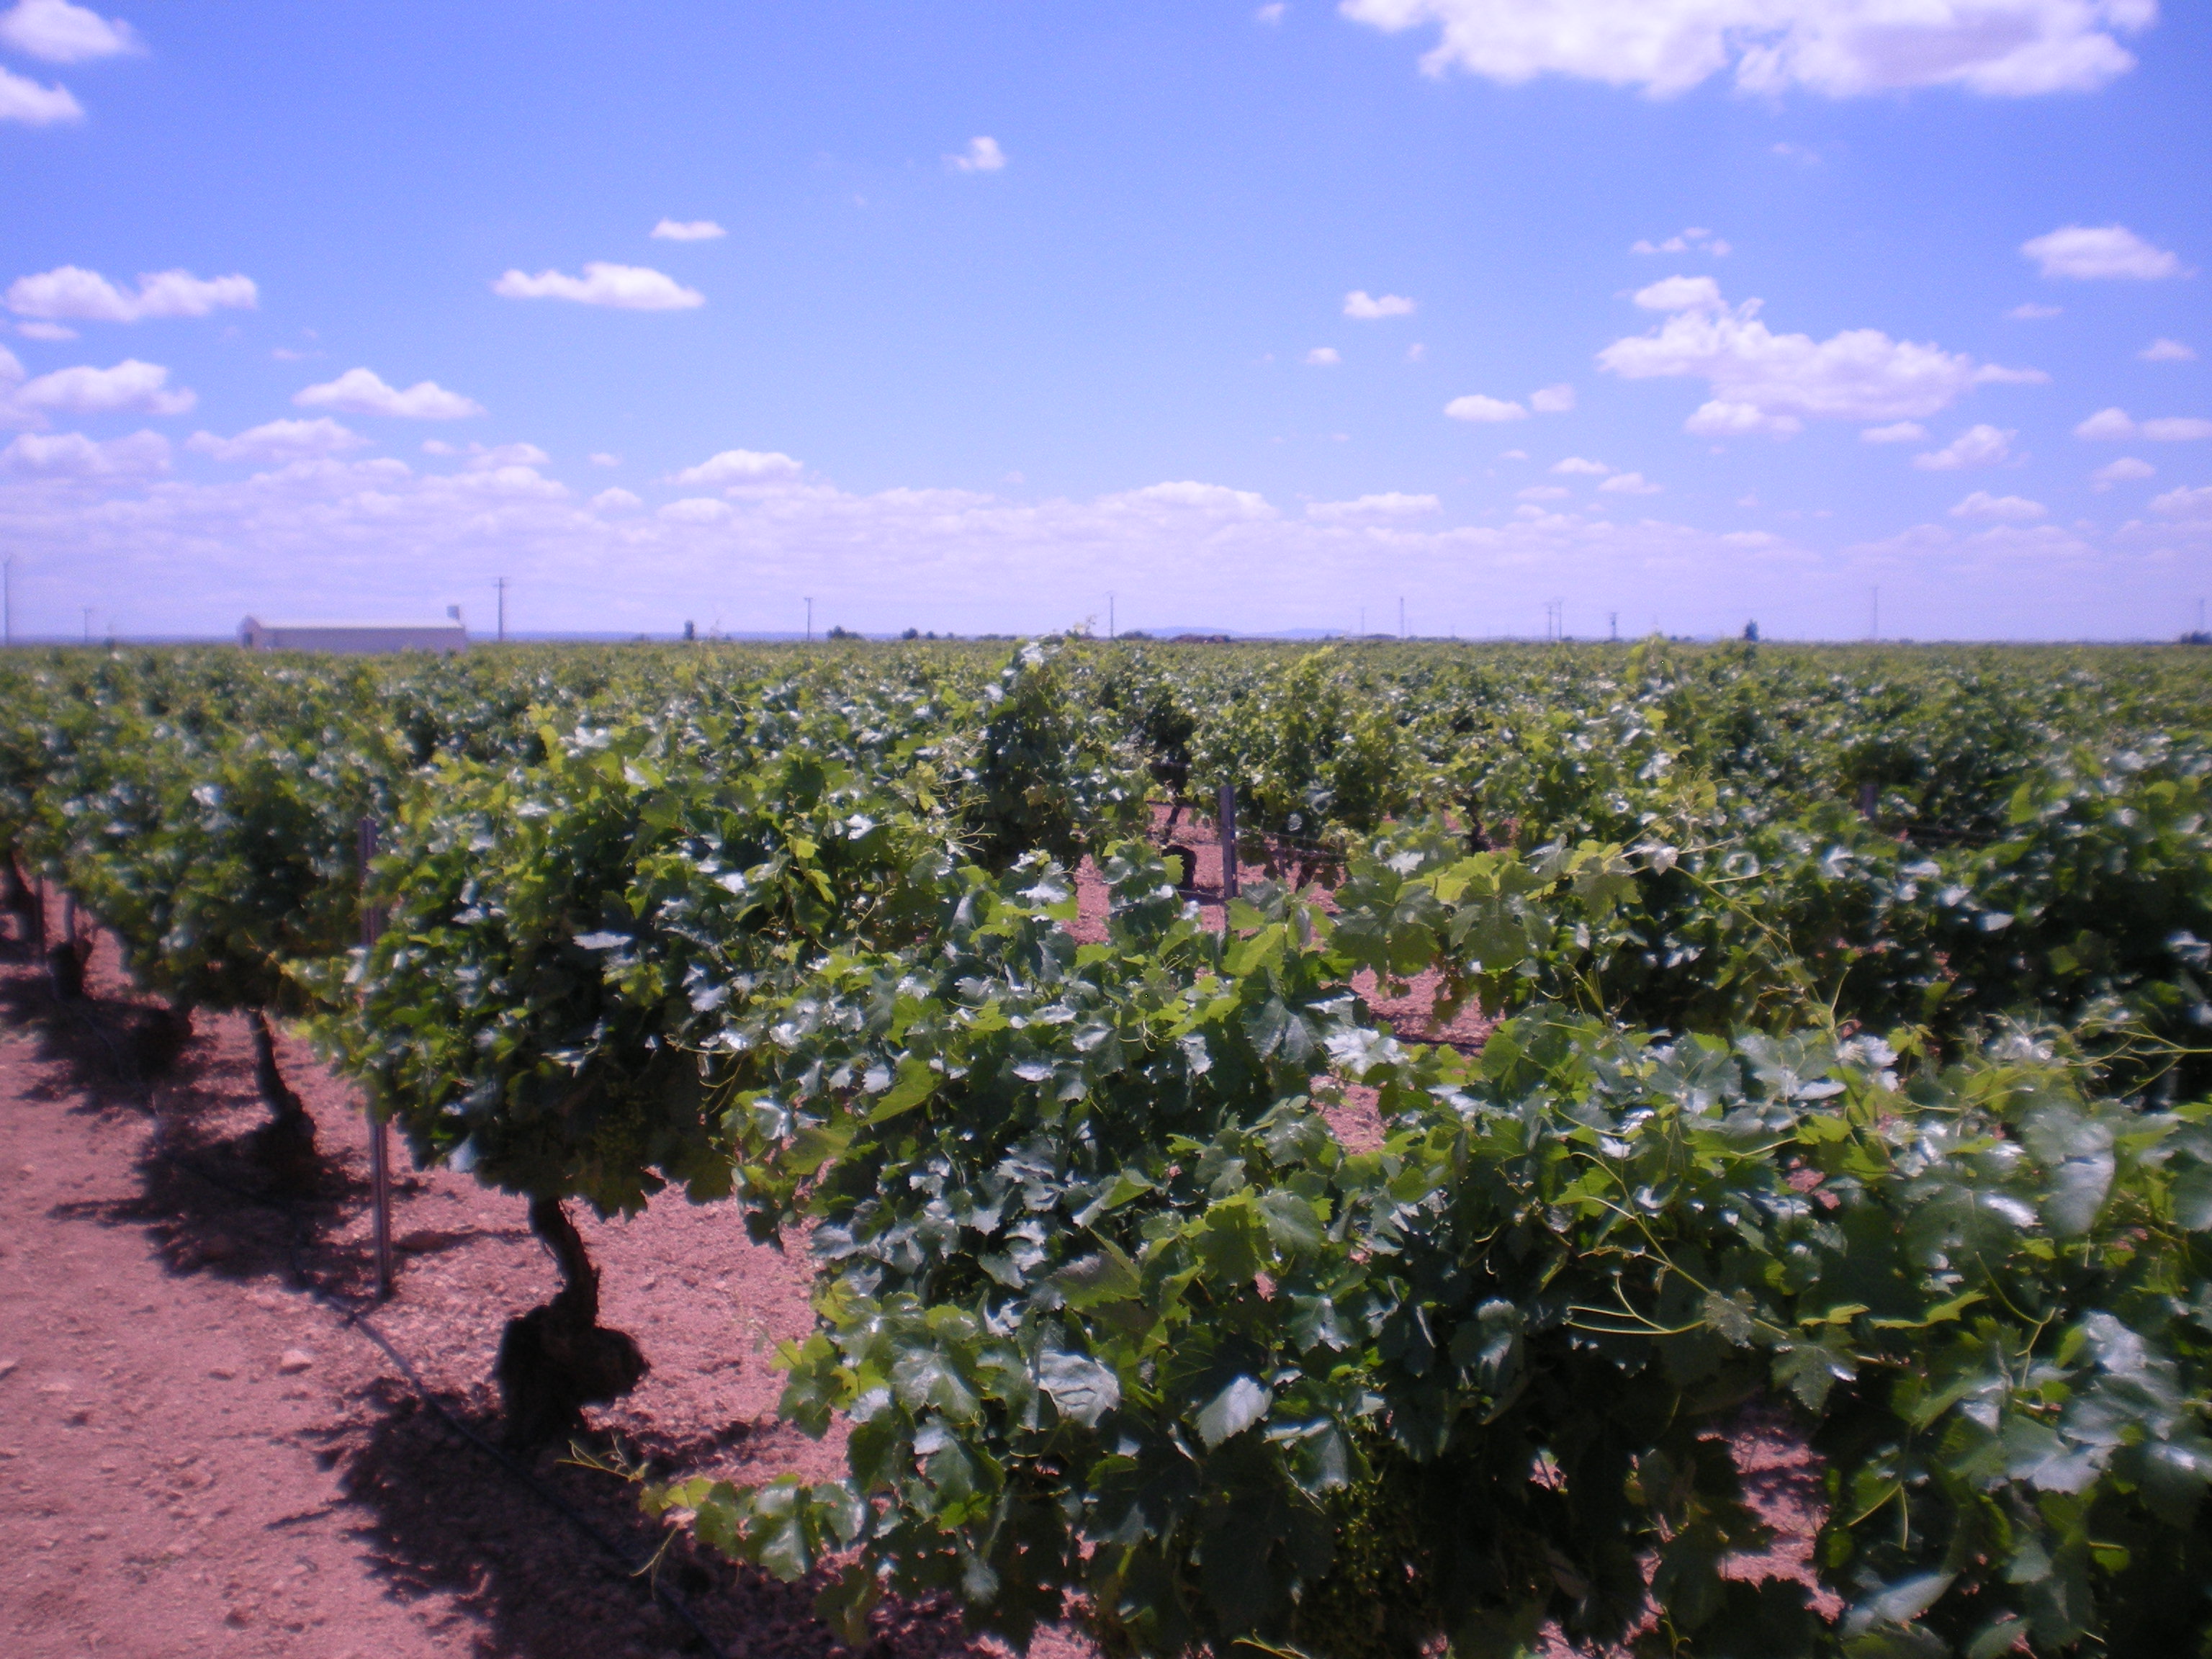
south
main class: Cropland
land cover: Vineyards
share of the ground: 25 - 50 %
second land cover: Other bare soil
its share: > 75 %
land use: Agriculture (excluding fallow land and kitchen gardens)
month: June
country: ES
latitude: 39.2274
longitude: -3.0457
